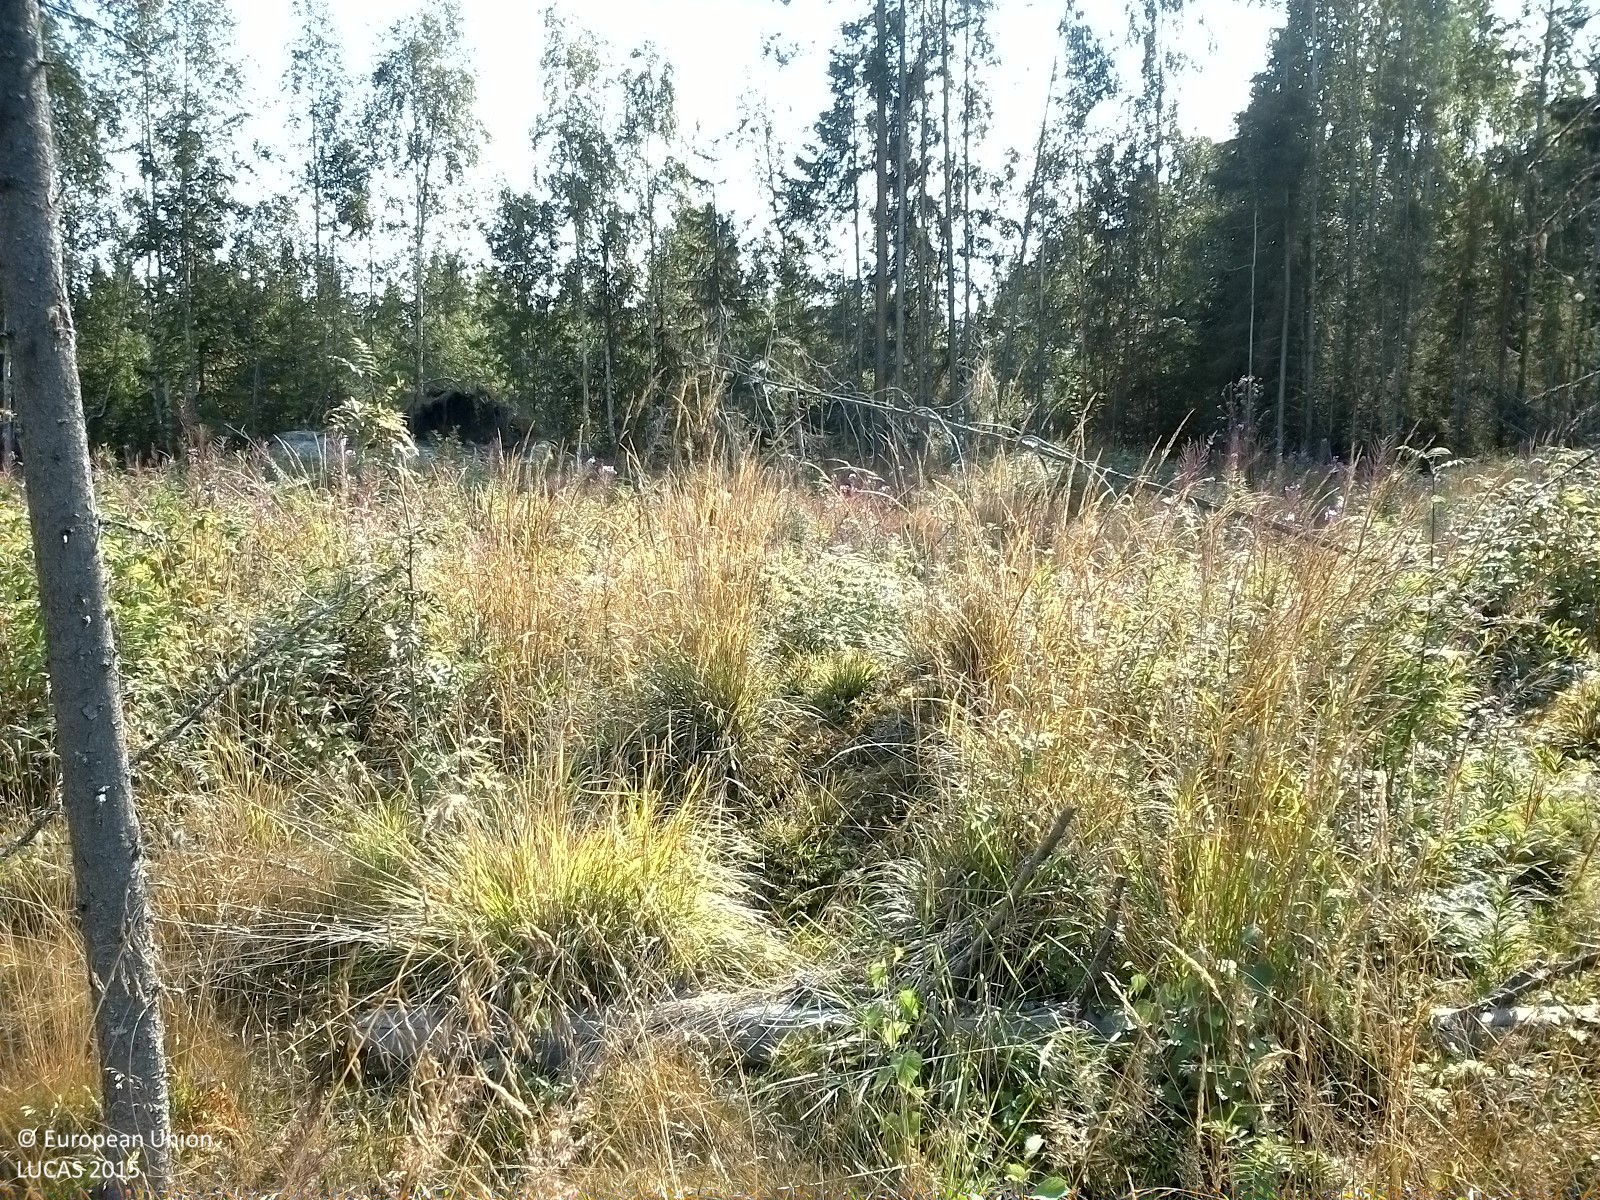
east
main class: Woodland
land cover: Spruce dominated mixed woodland
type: boreal forest
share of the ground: 10 - 25 %
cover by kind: herbaceous plants 50 %, shrubs 30 %, coniferous forest trees 10 %, broadleaved forest trees 10 %
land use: Forestry
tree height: < 5 m
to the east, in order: Spruce dominated mixed woodland; Ditches and canals; Grassland without tree/shrub cover; Pine dominated mixed woodland; Grassland without tree/shrub cover; Other mixed woodland; Rivers and streams; Spruce dominated mixed woodland; Other mixed woodland
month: August
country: SE
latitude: 62.4616
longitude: 16.3191
